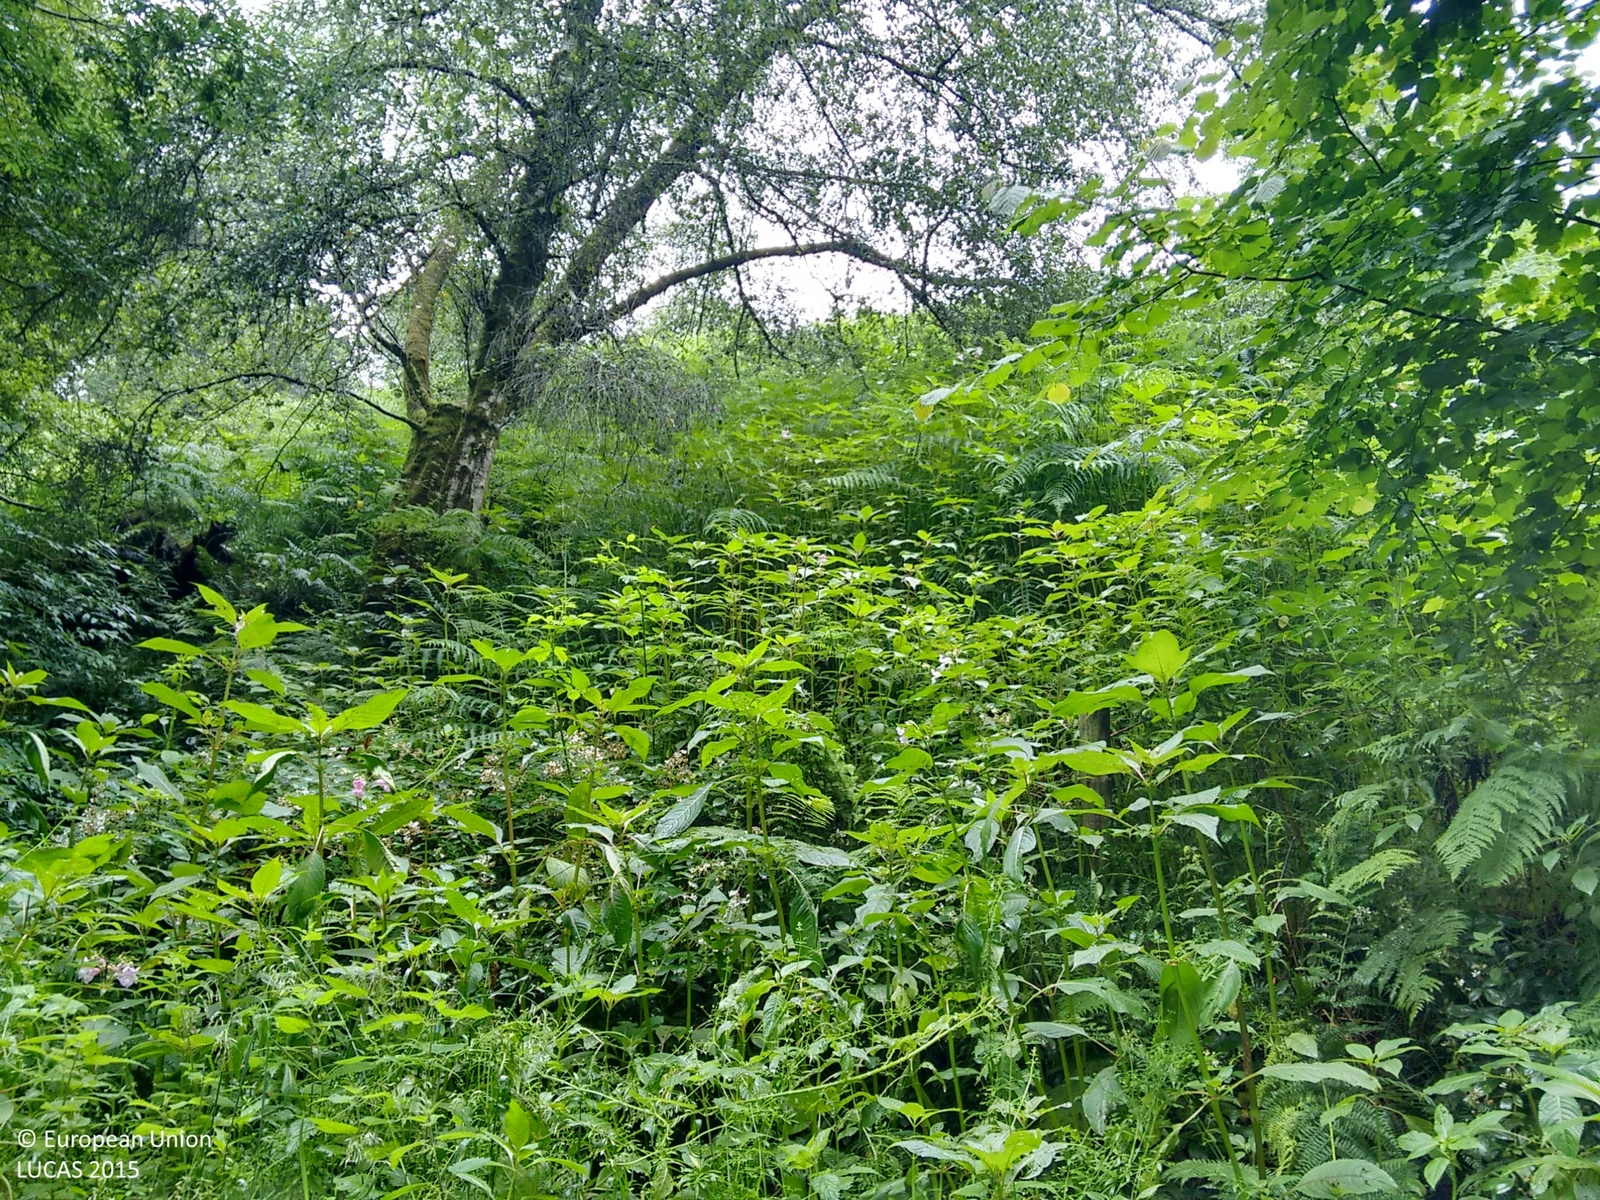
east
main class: Woodland
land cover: Broadleaved woodland
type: mesophytic deciduous forest
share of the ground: > 75 %
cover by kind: broadleaved forest trees 50 %, shrubs 50 %
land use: Forestry
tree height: > 5 m
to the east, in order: Broadleaved woodland; Fences; Broadleaved woodland; Grassland without tree/shrub cover; Fences; Grassland without tree/shrub cover; Ditches and canals; Lines of trees
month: July
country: GB
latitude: 51.6151
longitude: -3.3833
